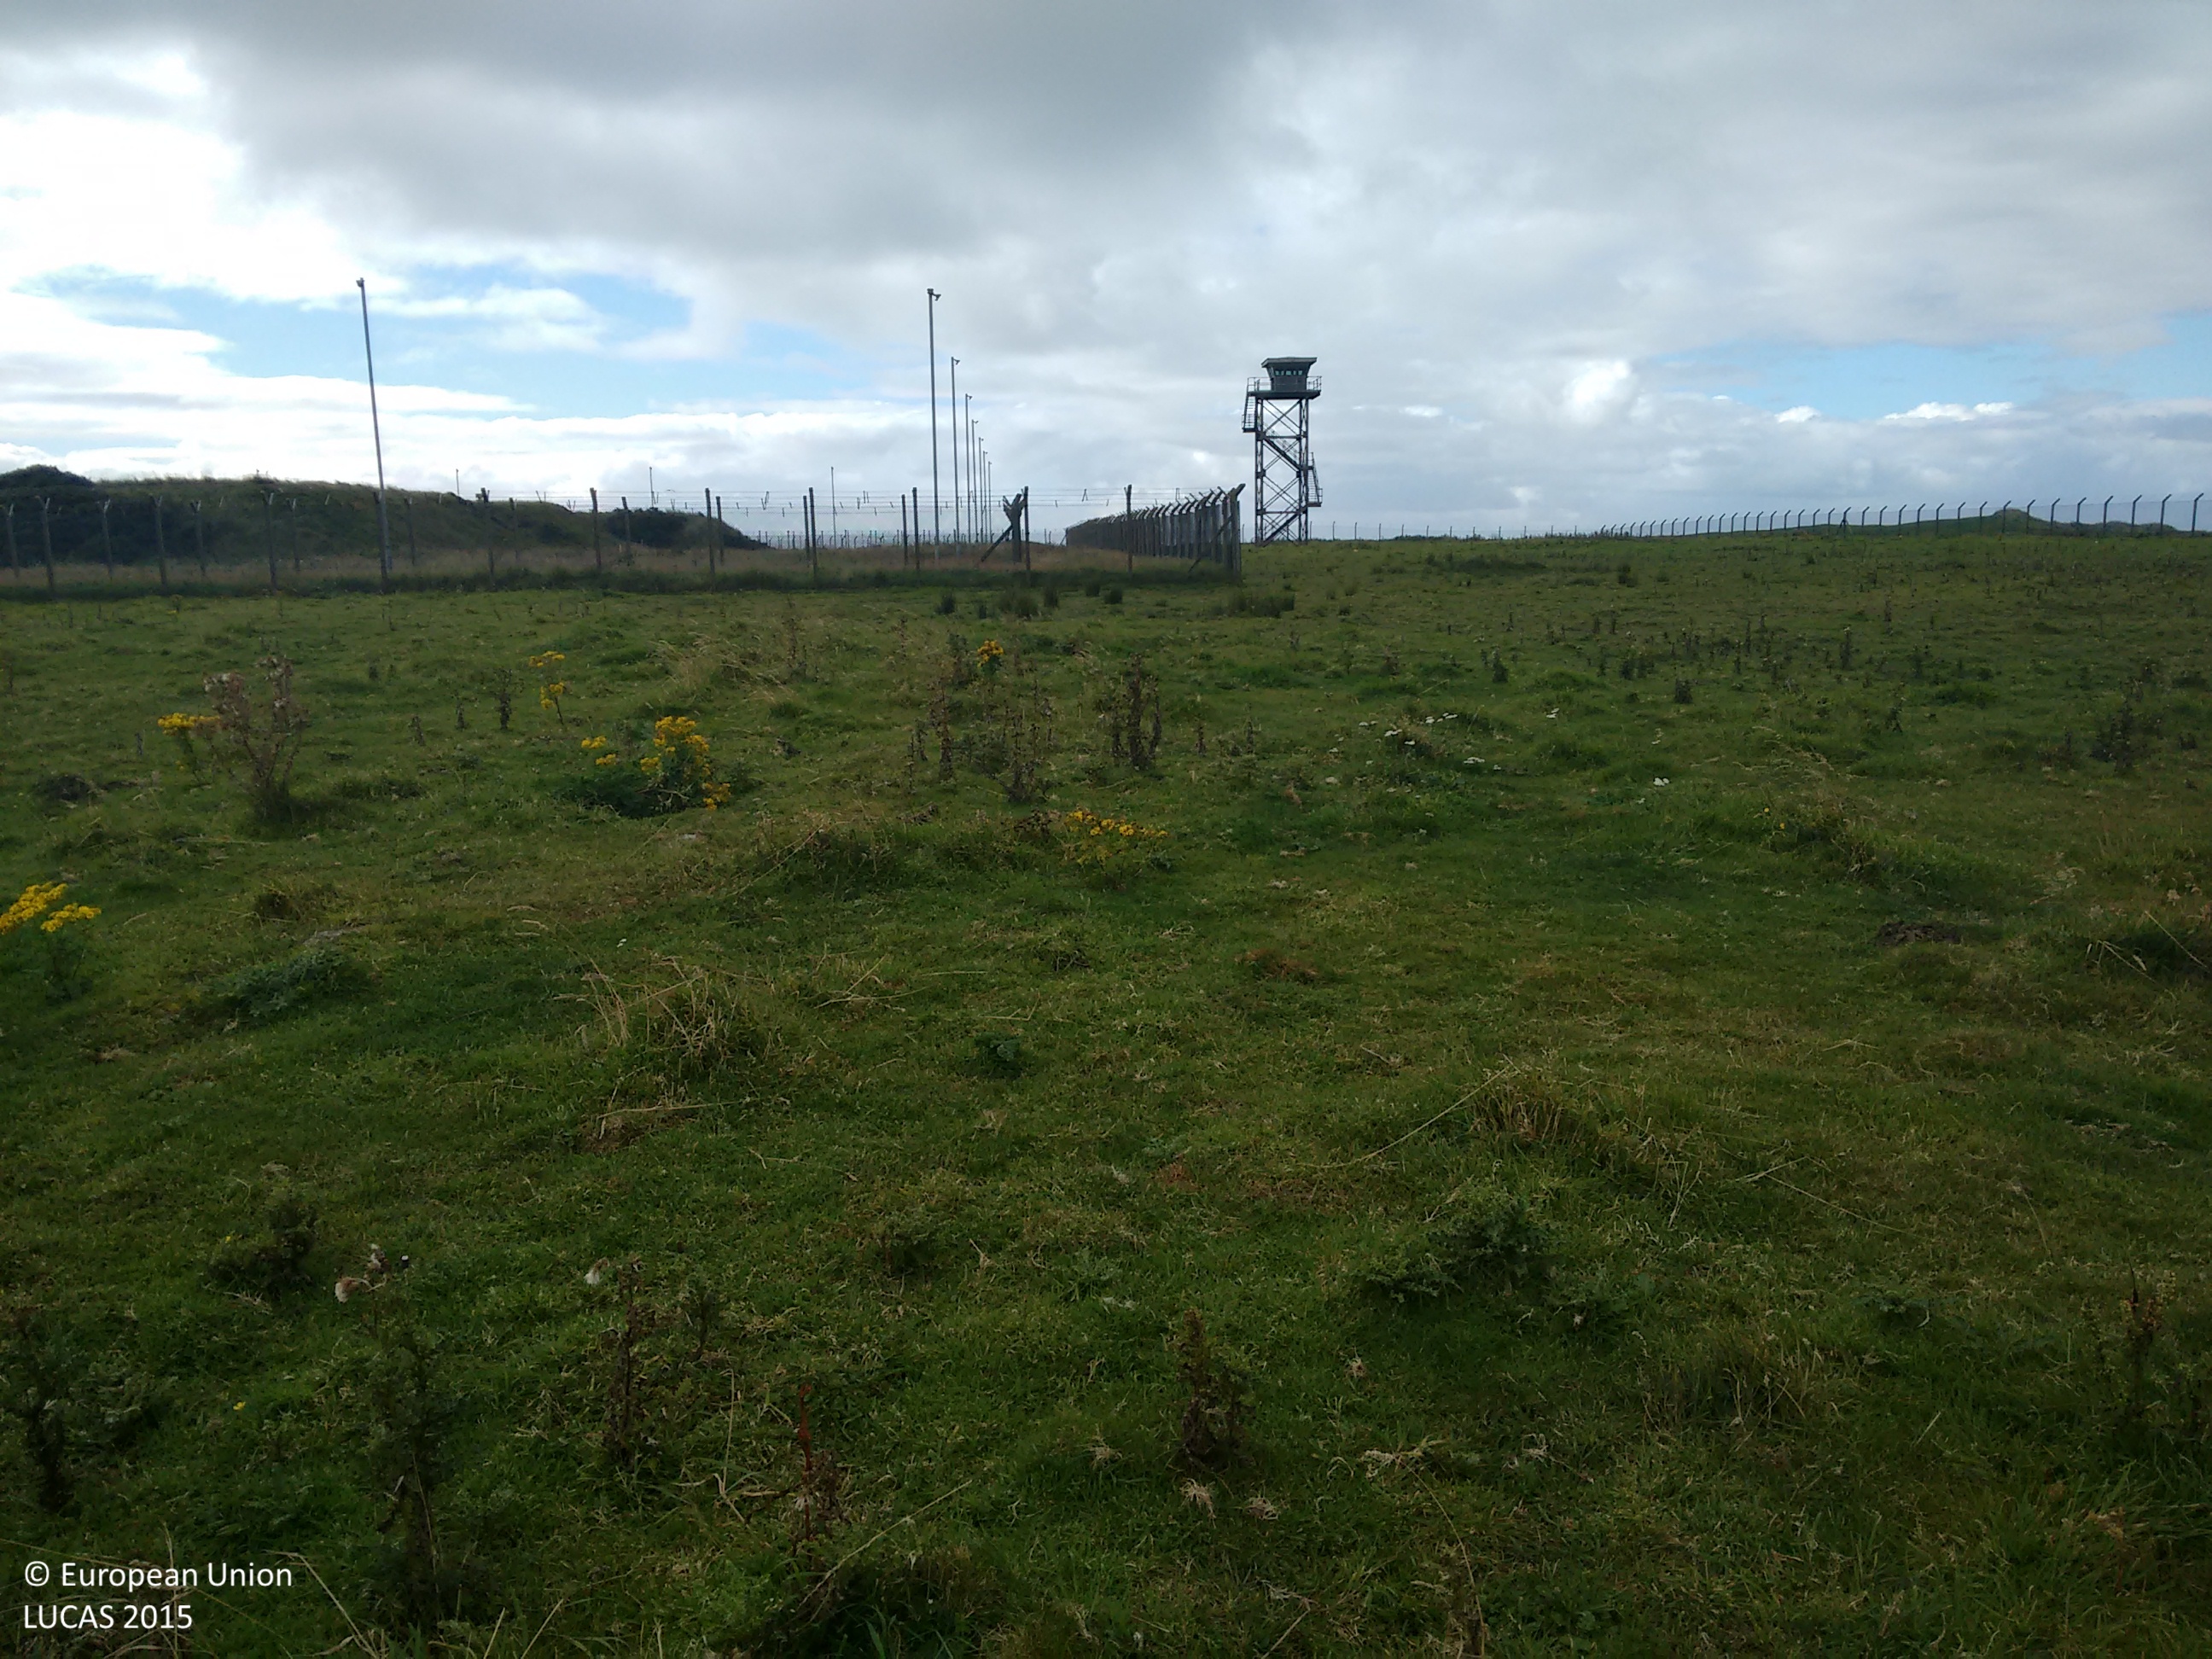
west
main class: Grassland
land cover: Grassland without tree/shrub cover
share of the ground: > 75 %
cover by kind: herbaceous plants 100 %
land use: Semi-natural and natural areas not in use
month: September
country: GB
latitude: 55.4505
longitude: -5.7036
